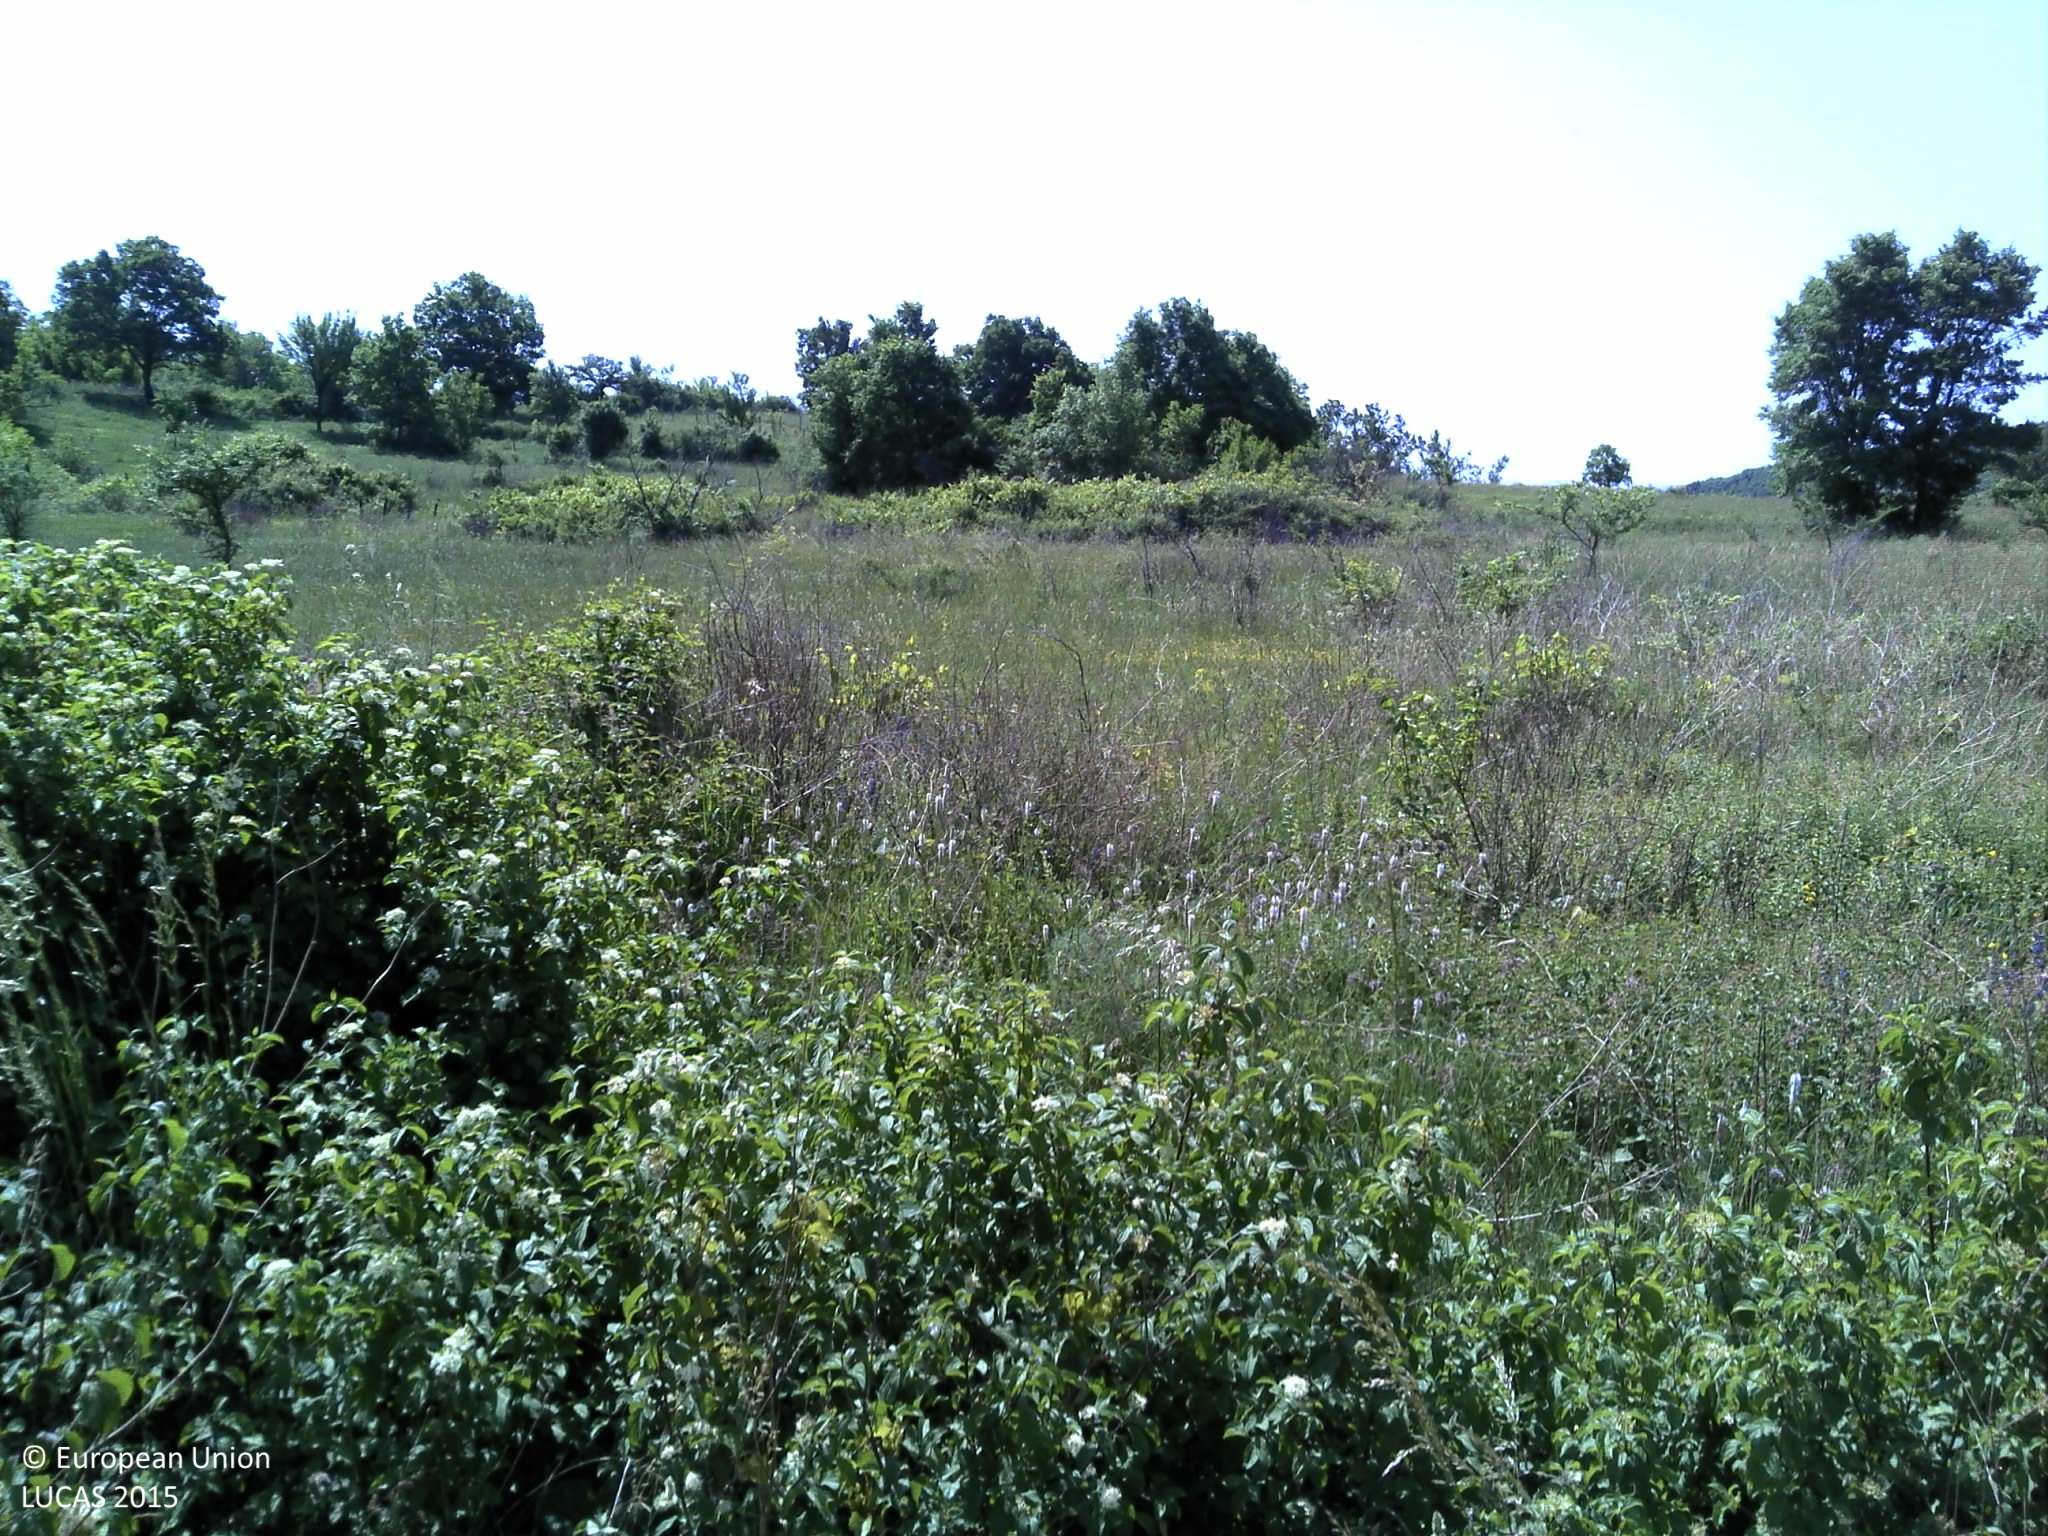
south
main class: Grassland
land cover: Grassland with sparse tree/shrub cover
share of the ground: > 75 %
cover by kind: herbaceous plants 85 %, shrubs 10 %, broadleaved forest trees 5 %
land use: Abandoned areas
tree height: < 5 m
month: May
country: HR
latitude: 43.9655
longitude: 16.2116
